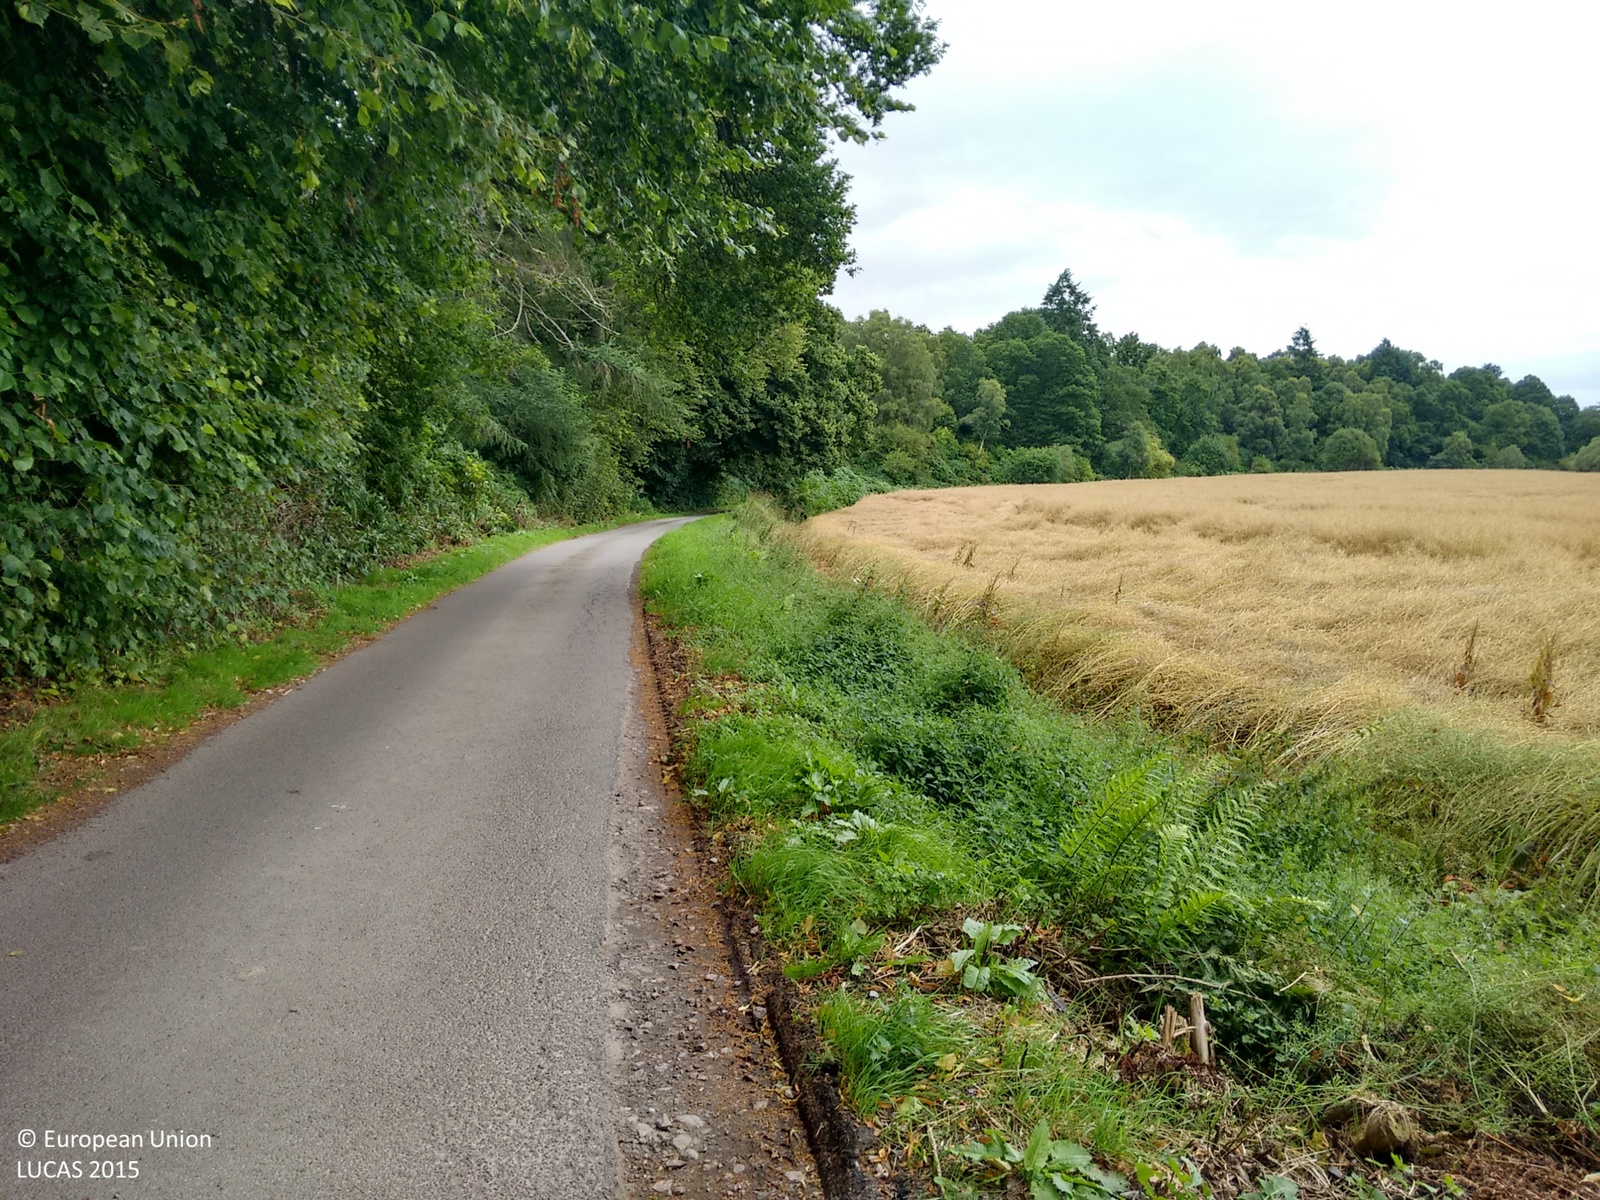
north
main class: Cropland
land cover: Rape and turnip rape
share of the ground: > 75 %
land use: Agriculture (excluding fallow land and kitchen gardens)
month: August
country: GB
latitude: 57.4661
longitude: -4.4785
